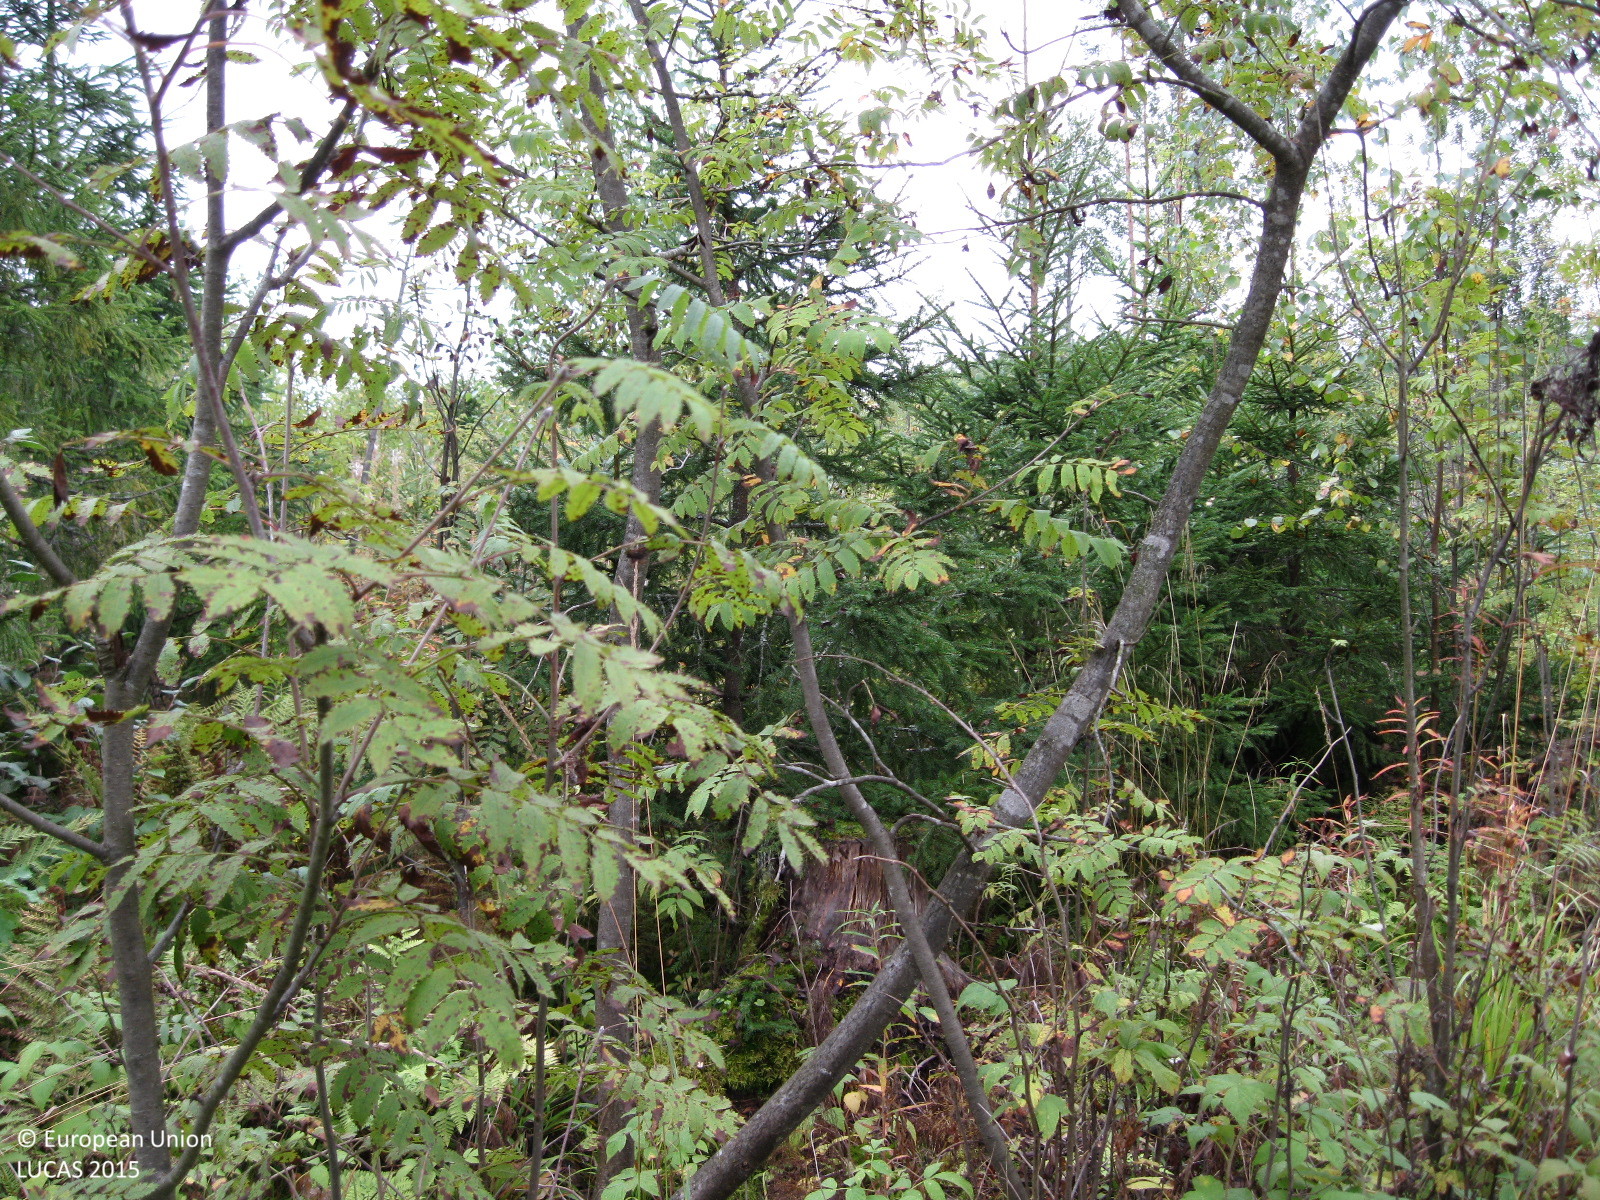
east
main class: Woodland
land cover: Broadleaved woodland
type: boreal forest
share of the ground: > 75 %
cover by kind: broadleaved forest trees 65 %, herbaceous plants 15 %, coniferous forest trees 10 %, shrubs 10 %
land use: Forestry
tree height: > 5 m
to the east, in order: Broadleaved woodland; Ditches and canals; Grass margins; Tracks; Grassland without tree/shrub cover; Tracks; Grass margins; Ditches and canals; Pine dominated mixed woodland
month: September
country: FI
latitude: 60.4816
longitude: 24.7592
